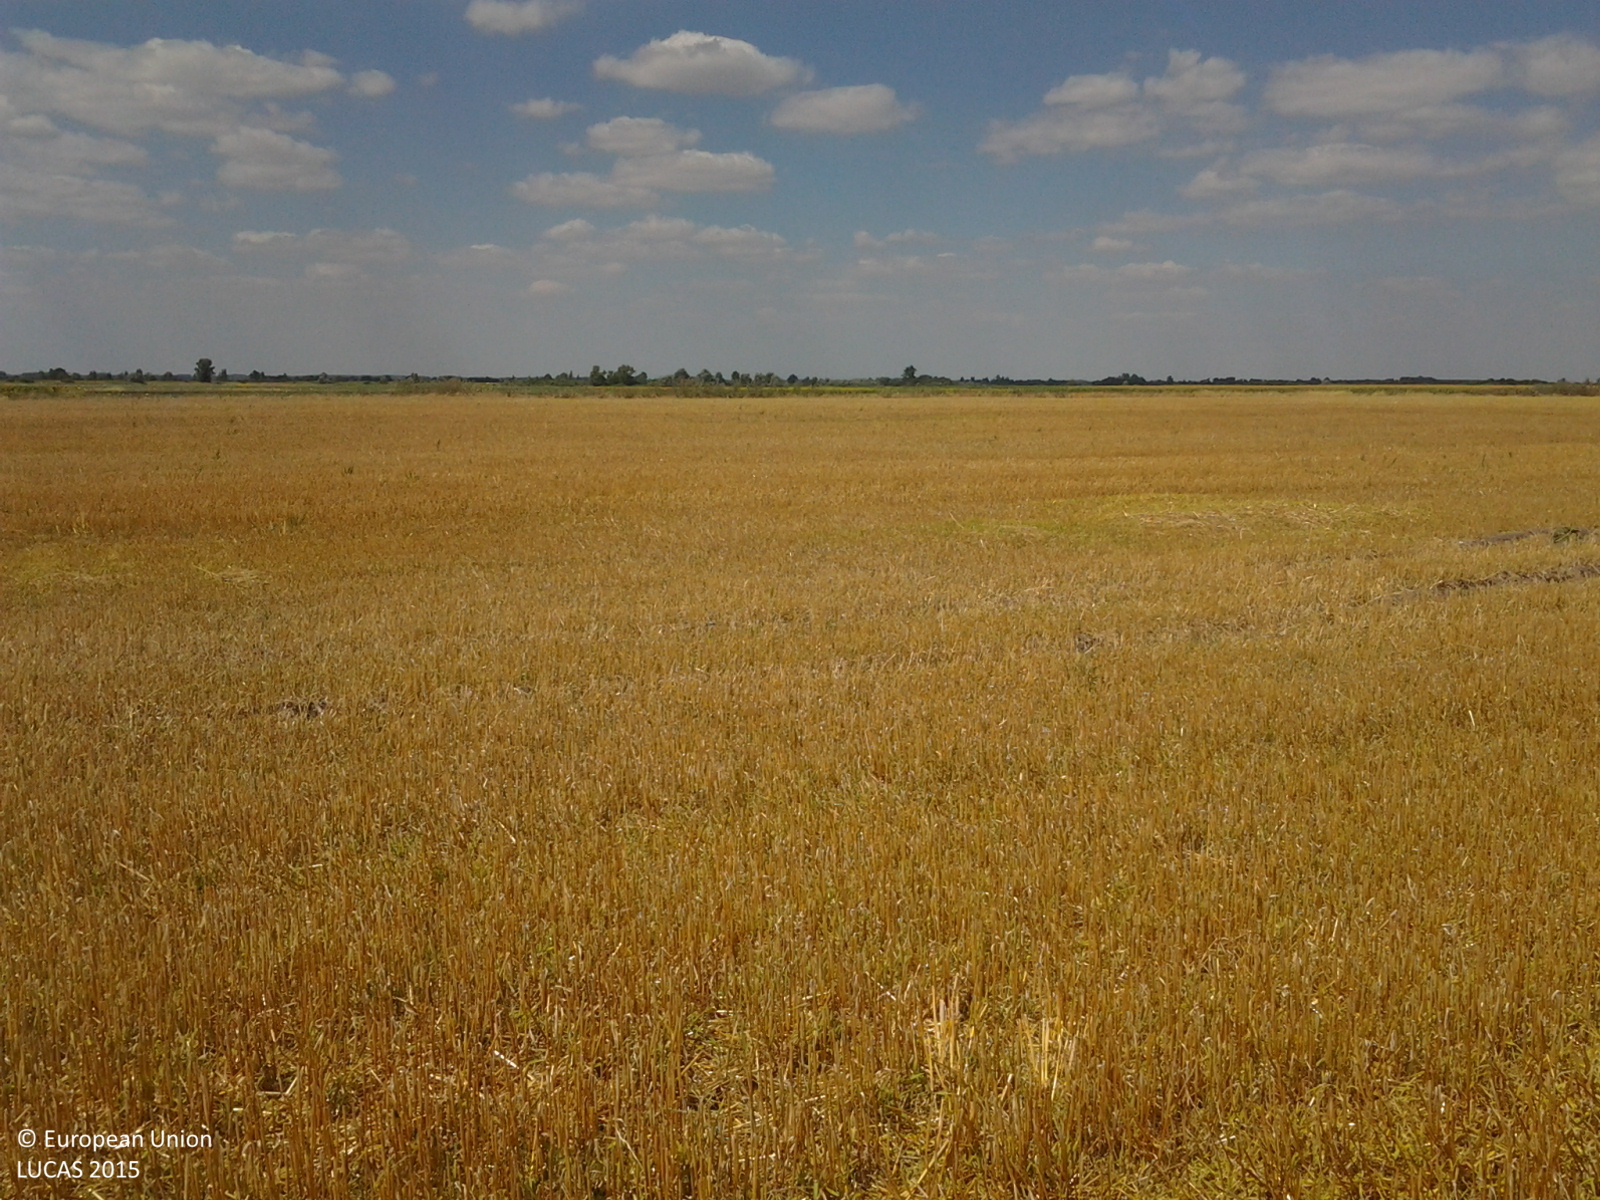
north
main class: Cropland
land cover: Barley
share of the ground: 10 - 25 %
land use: Agriculture (excluding fallow land and kitchen gardens)
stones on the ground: < 10 %
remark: Harvested field
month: July
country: HU
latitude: 47.3905
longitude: 20.5364
